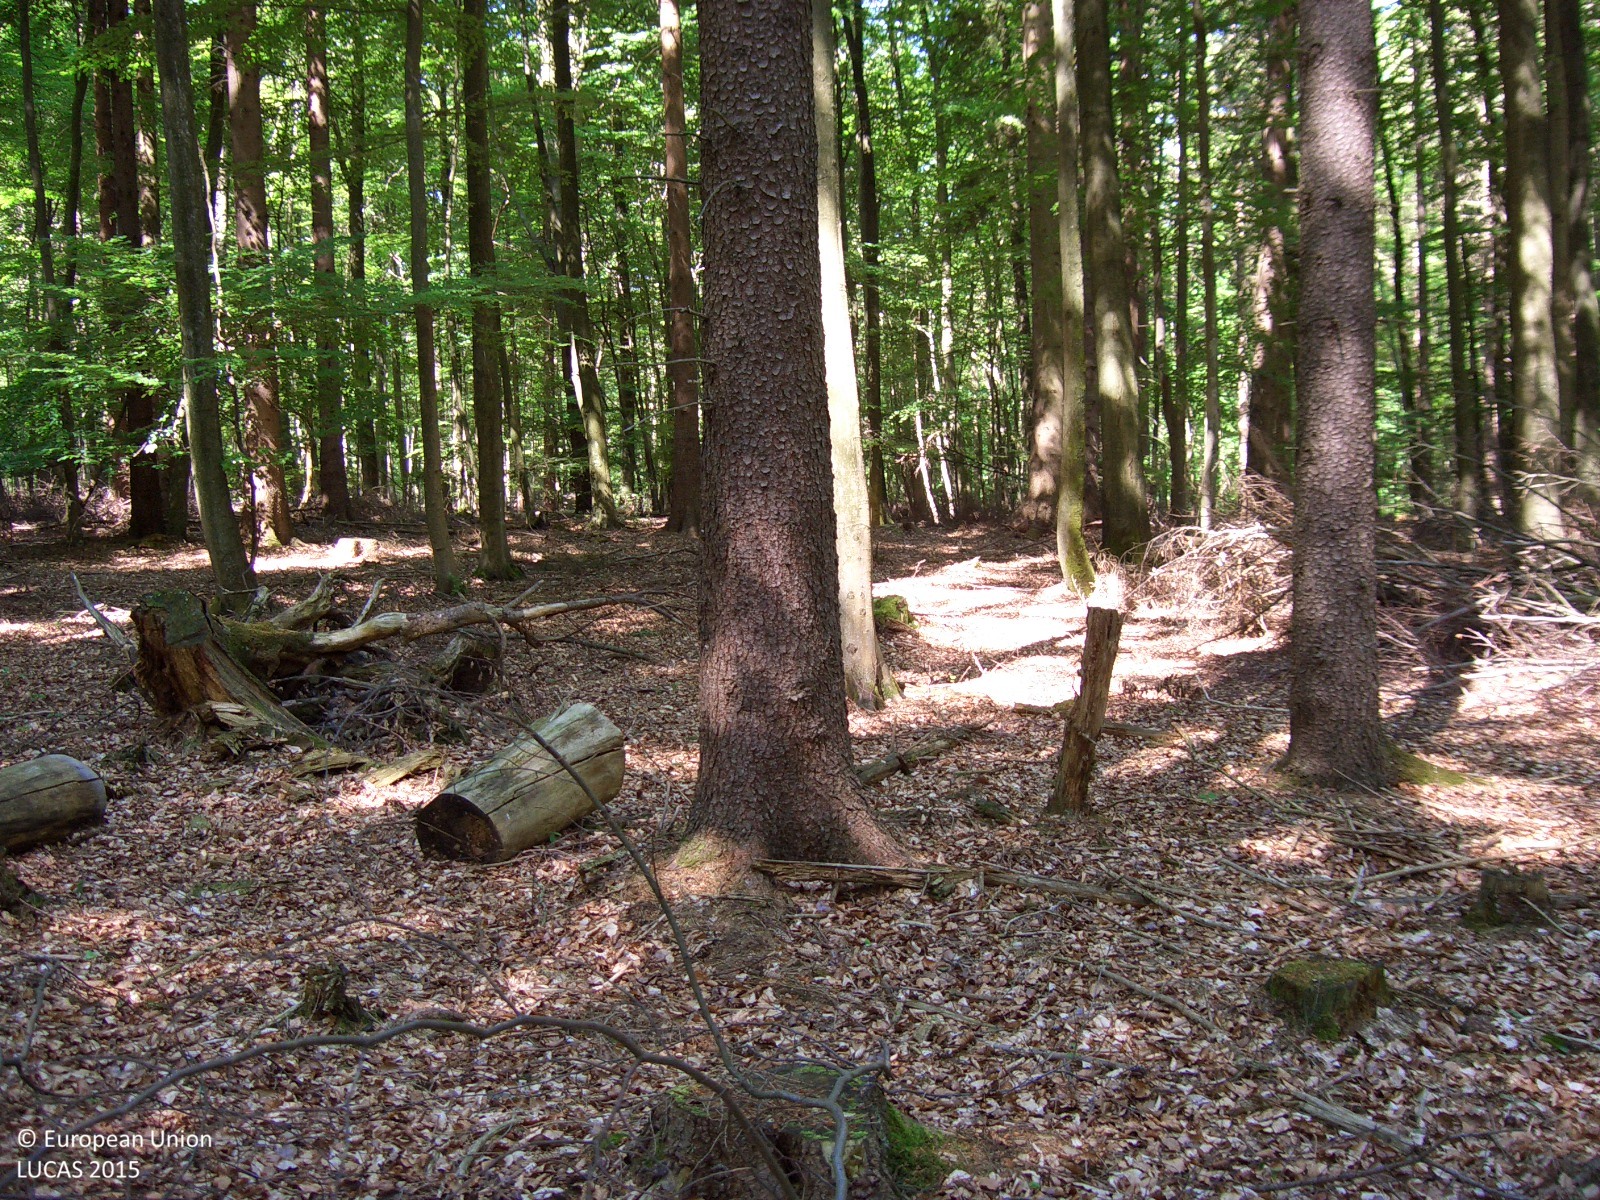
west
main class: Woodland
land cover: Spruce dominated mixed woodland
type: beech forest
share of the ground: > 75 %
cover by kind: broadleaved forest trees 70 %, coniferous forest trees 30 %
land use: Forestry
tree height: > 5 m
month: June
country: DE
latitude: 50.6985
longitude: 6.2475
